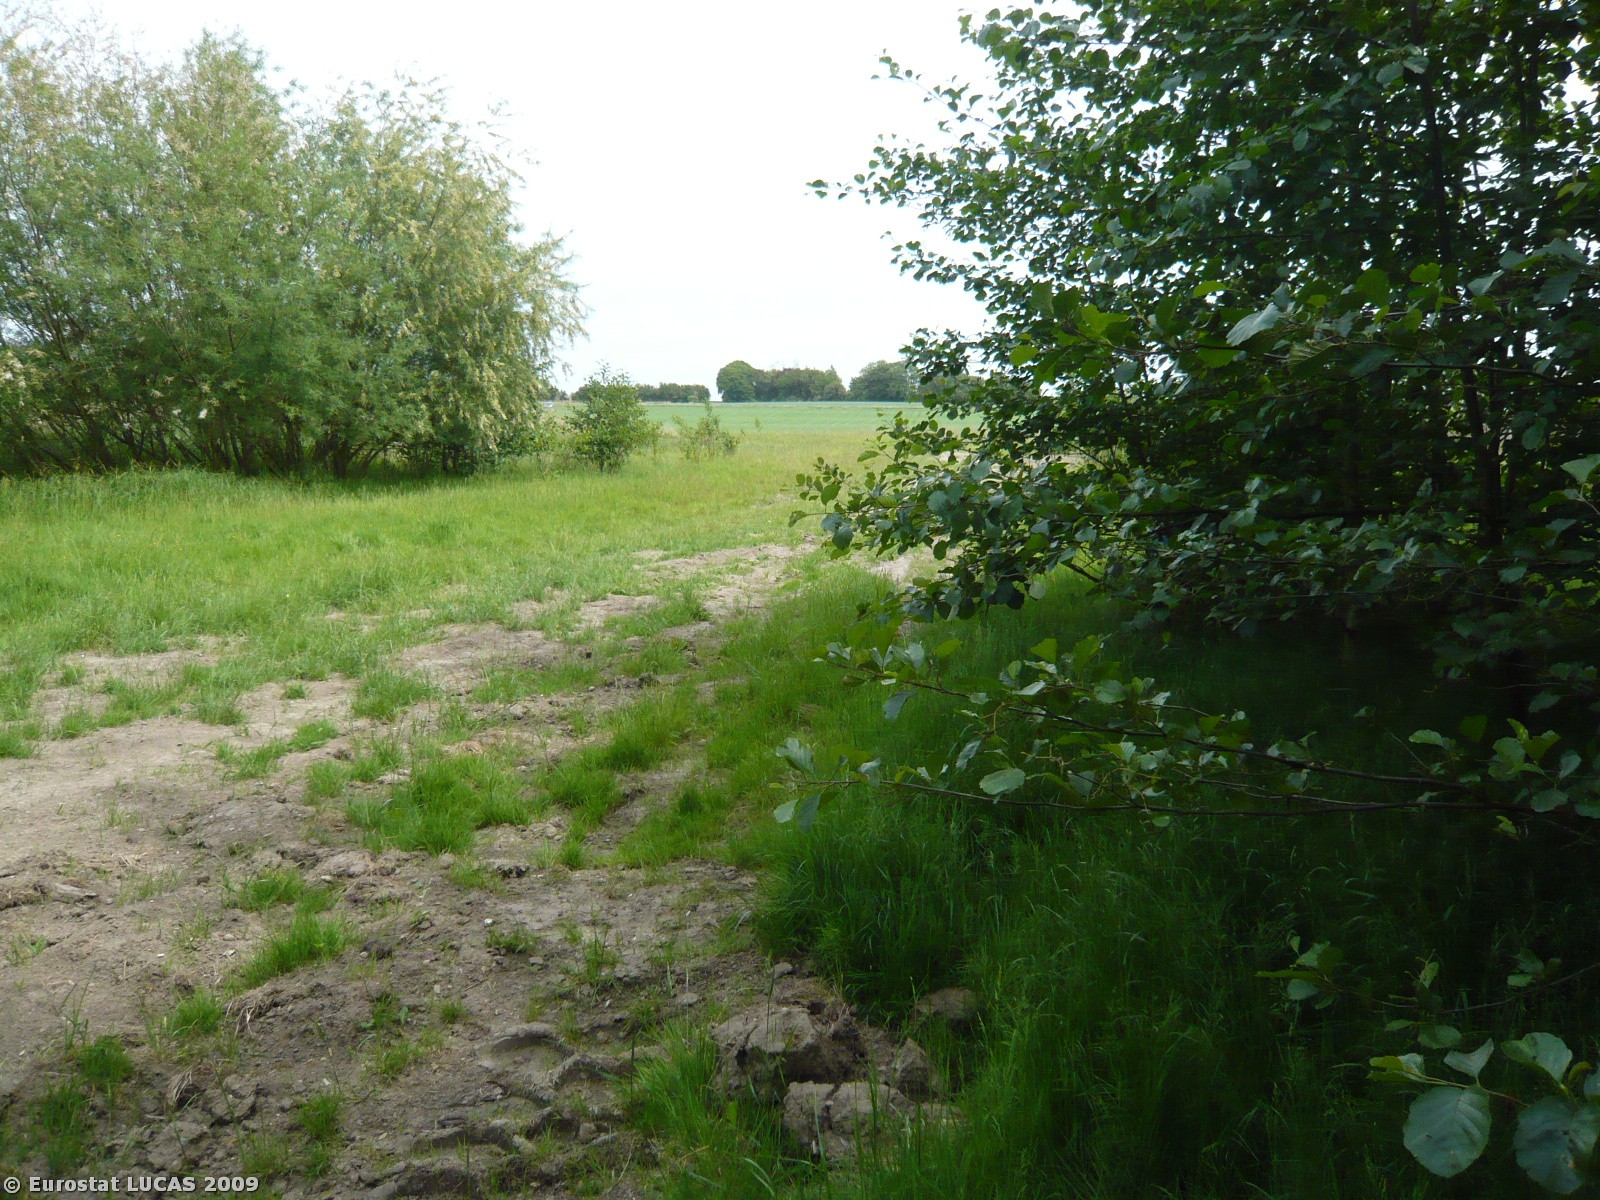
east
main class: Woodland
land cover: Broadleaved woodland
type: mire and swamp forests
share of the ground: > 75 %
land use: Unused
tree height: > 5 m
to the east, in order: Broadleaved woodland; Tracks; Grassland without tree/shrub cover; Tracks; Grassland without tree/shrub cover; Tracks; Barley
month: June
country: DK
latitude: 55.2456
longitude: 11.3673
